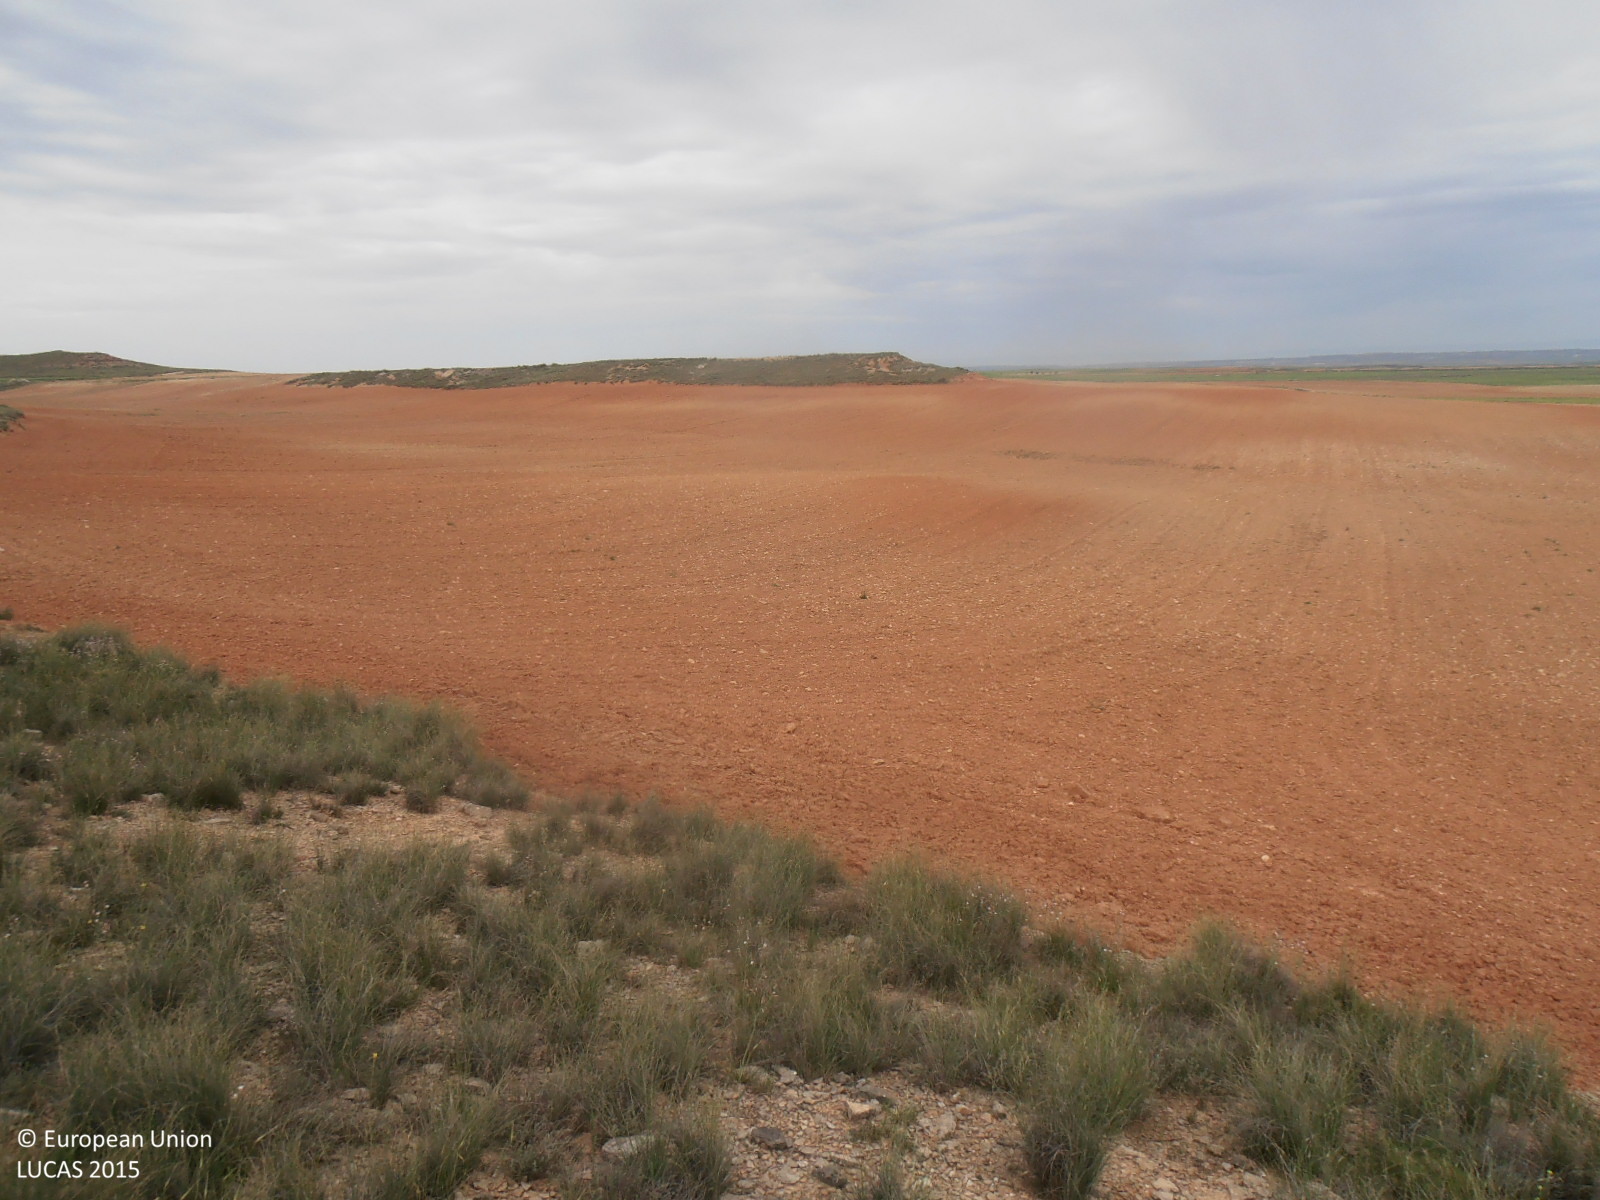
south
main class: Shrubland
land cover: Shrubland without tree cover
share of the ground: 50 - 75 %
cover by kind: shrubs 50 %, herbaceous plants 25 %, consolidated bare surface 25 %
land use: Semi-natural and natural areas not in use
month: April
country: ES
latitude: 41.3883
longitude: -0.4084
